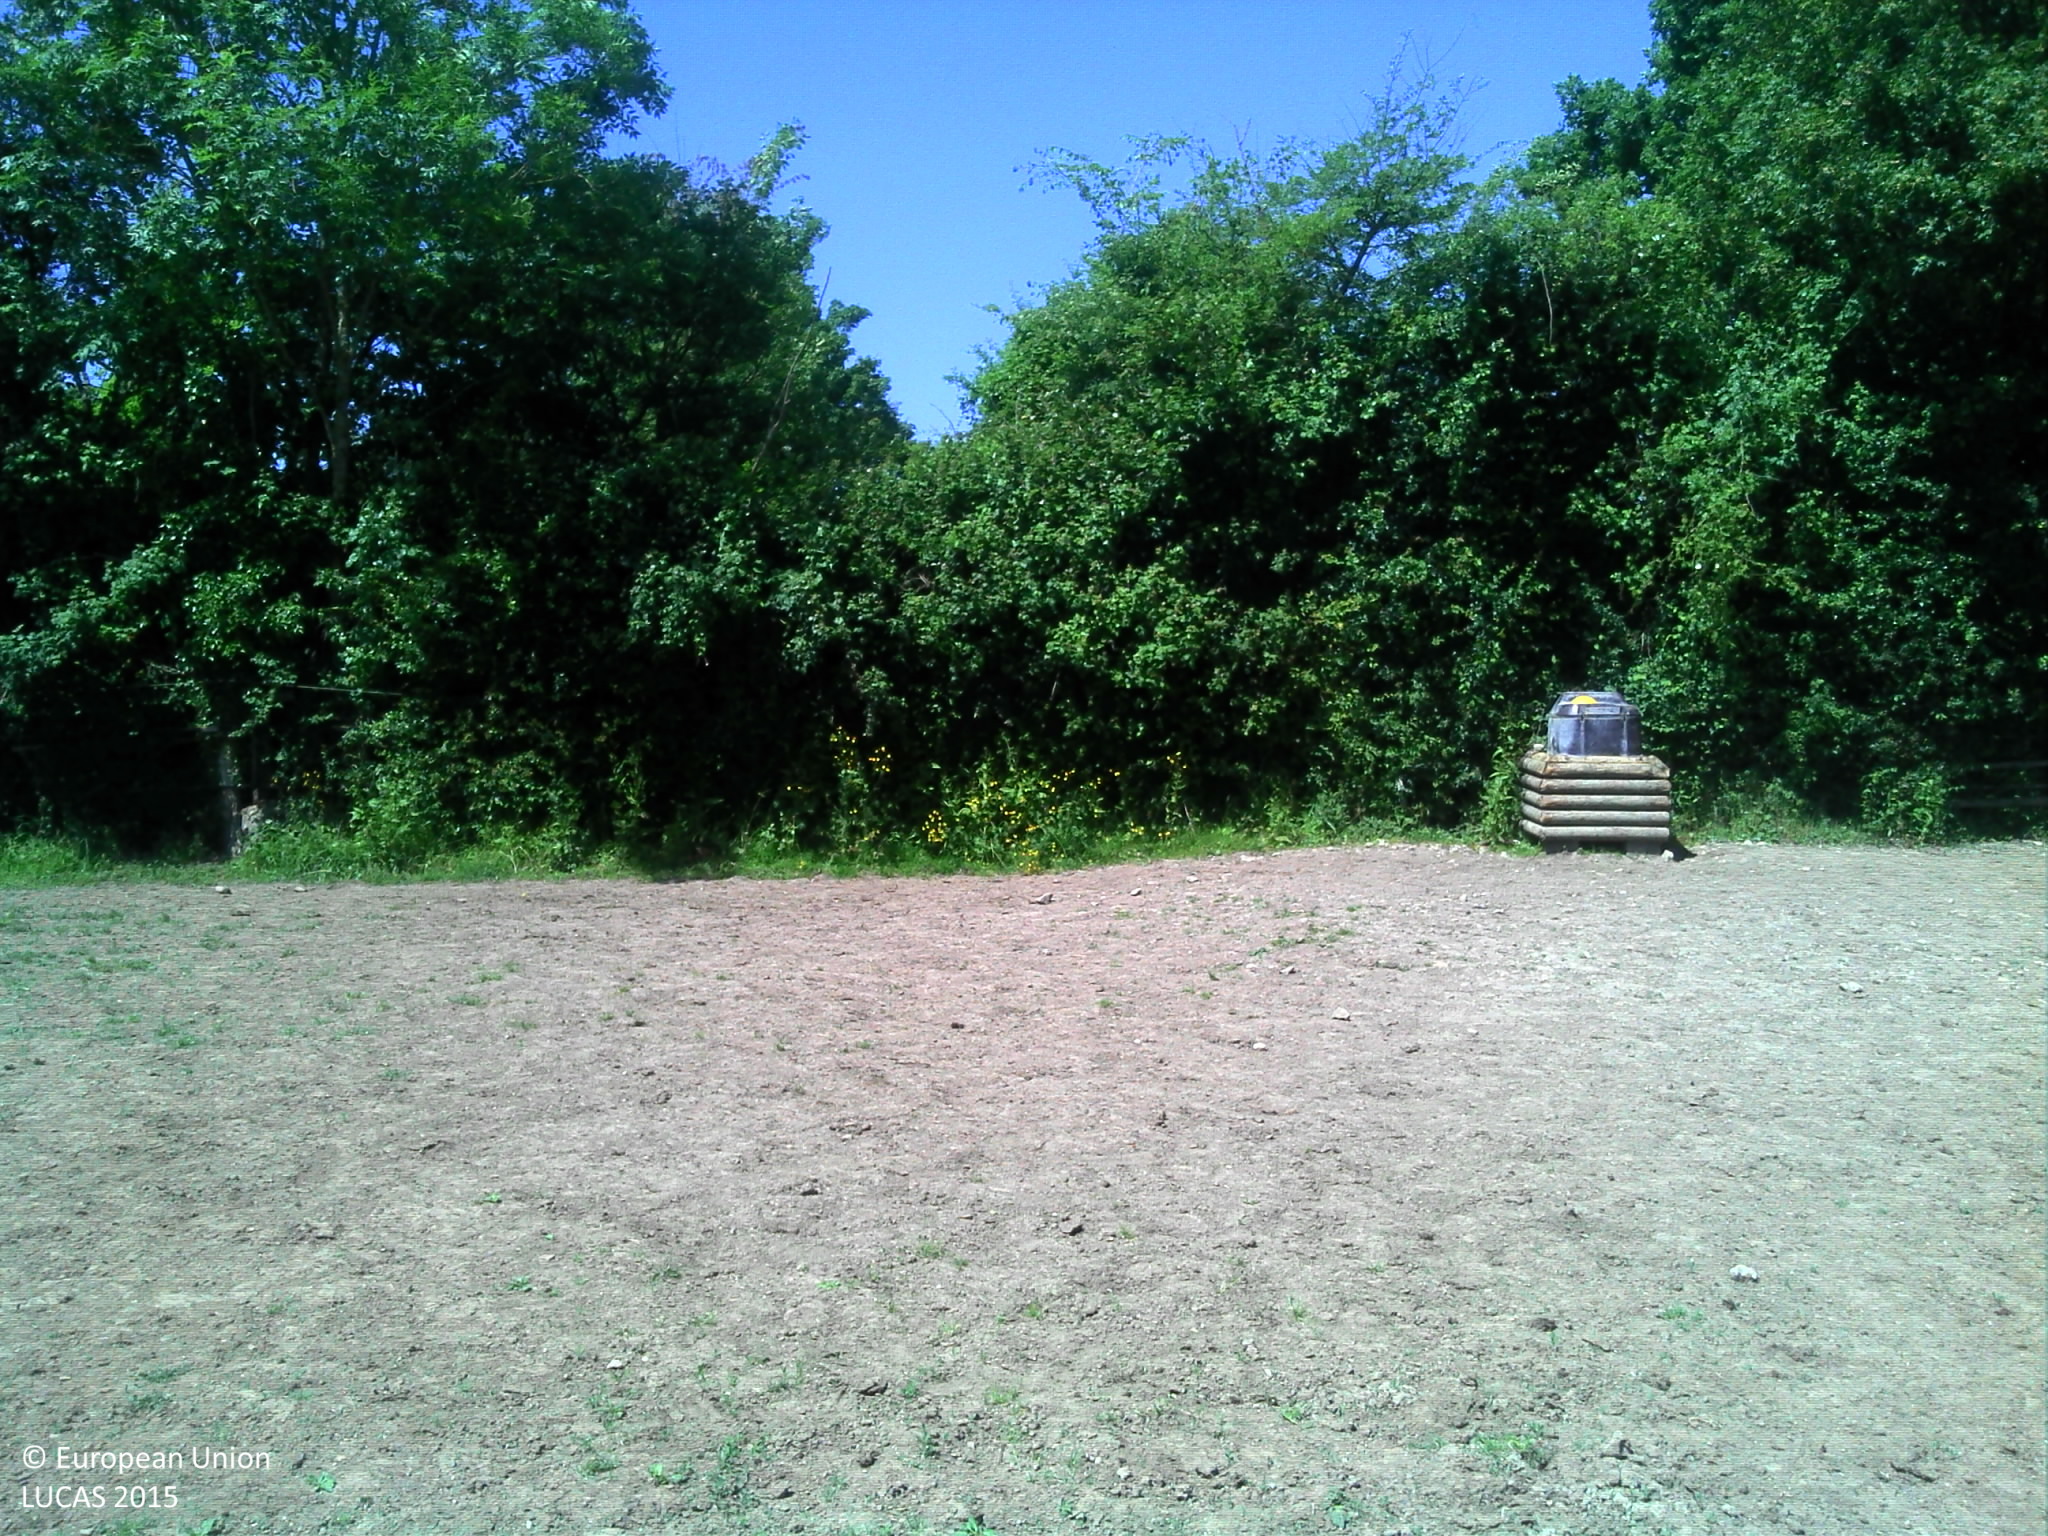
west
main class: Grassland
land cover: Grassland without tree/shrub cover
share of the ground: 50 - 75 %
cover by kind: herbaceous plants 85 %, unconsolidated bare surface 15 %
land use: Agriculture (excluding fallow land and kitchen gardens)
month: June
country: FR
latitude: 48.7589
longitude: 0.1360
